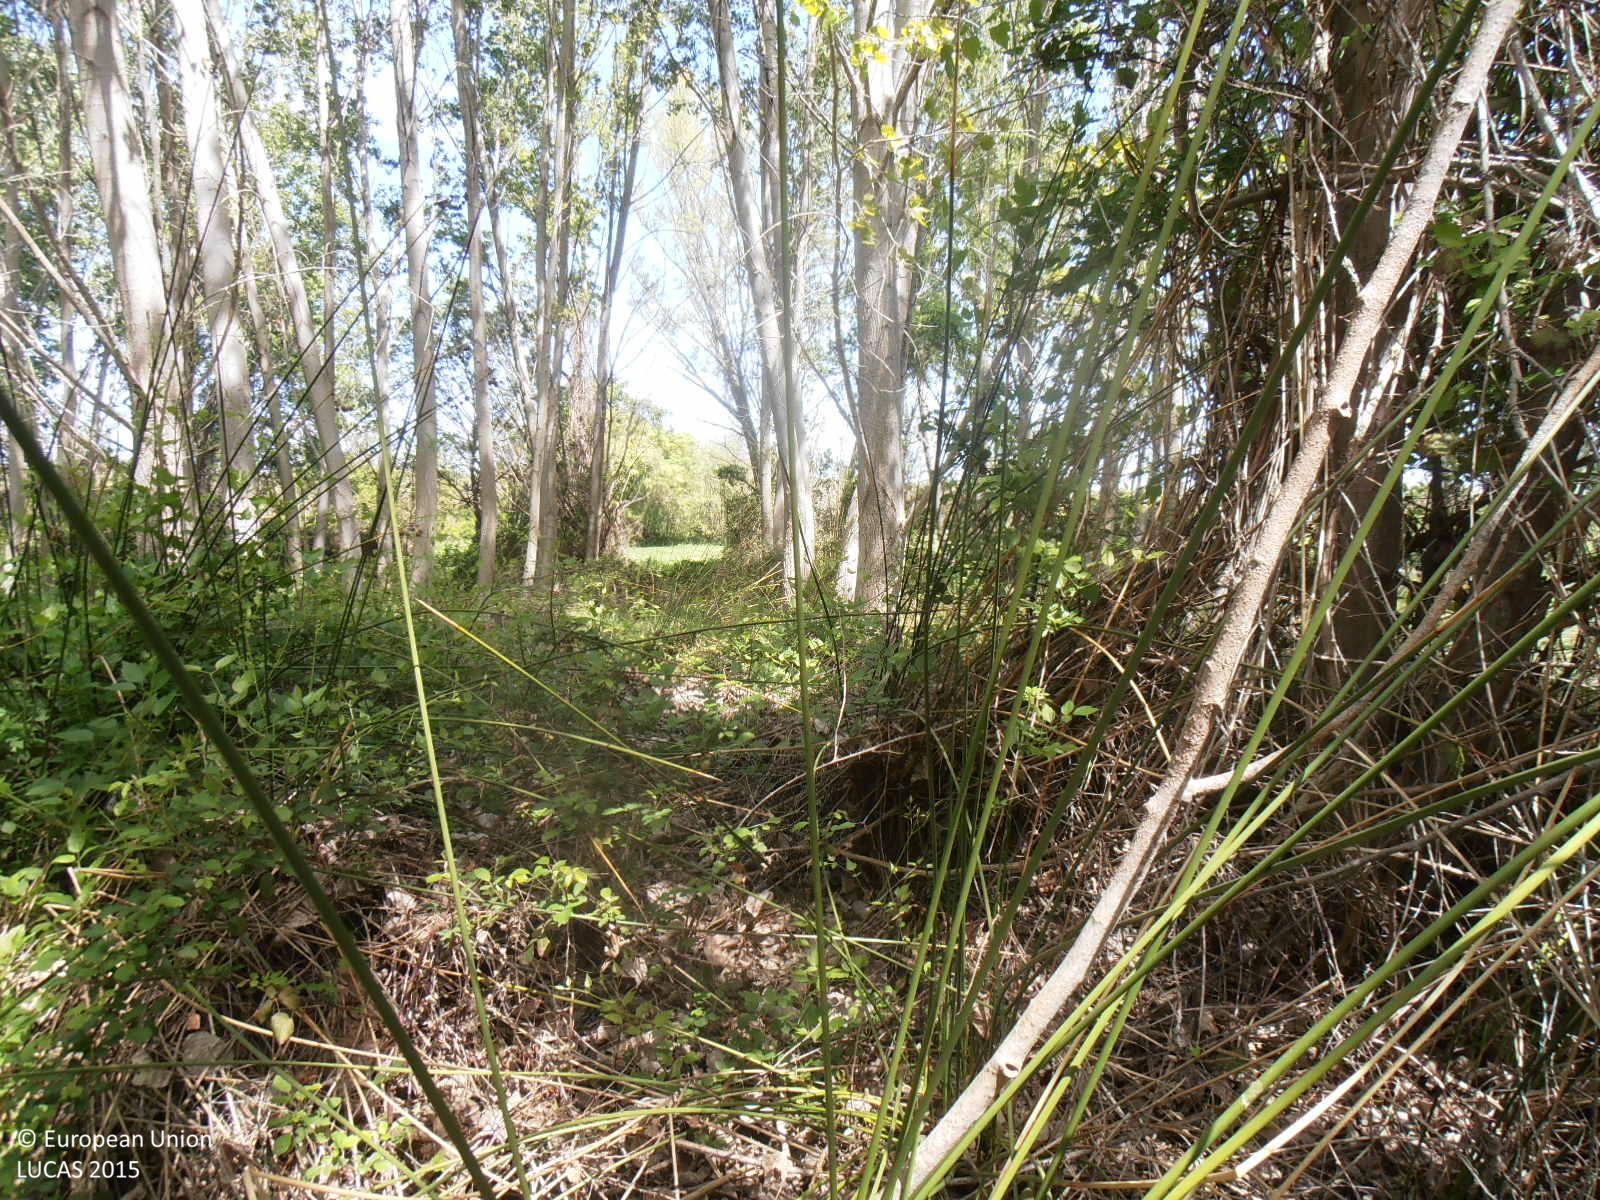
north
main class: Woodland
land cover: Broadleaved woodland
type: floodplain forest
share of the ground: > 75 %
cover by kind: broadleaved forest trees 80 %, herbaceous plants 20 %
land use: Forestry
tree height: > 5 m
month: April
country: ES
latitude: 41.2456
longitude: -0.8889
